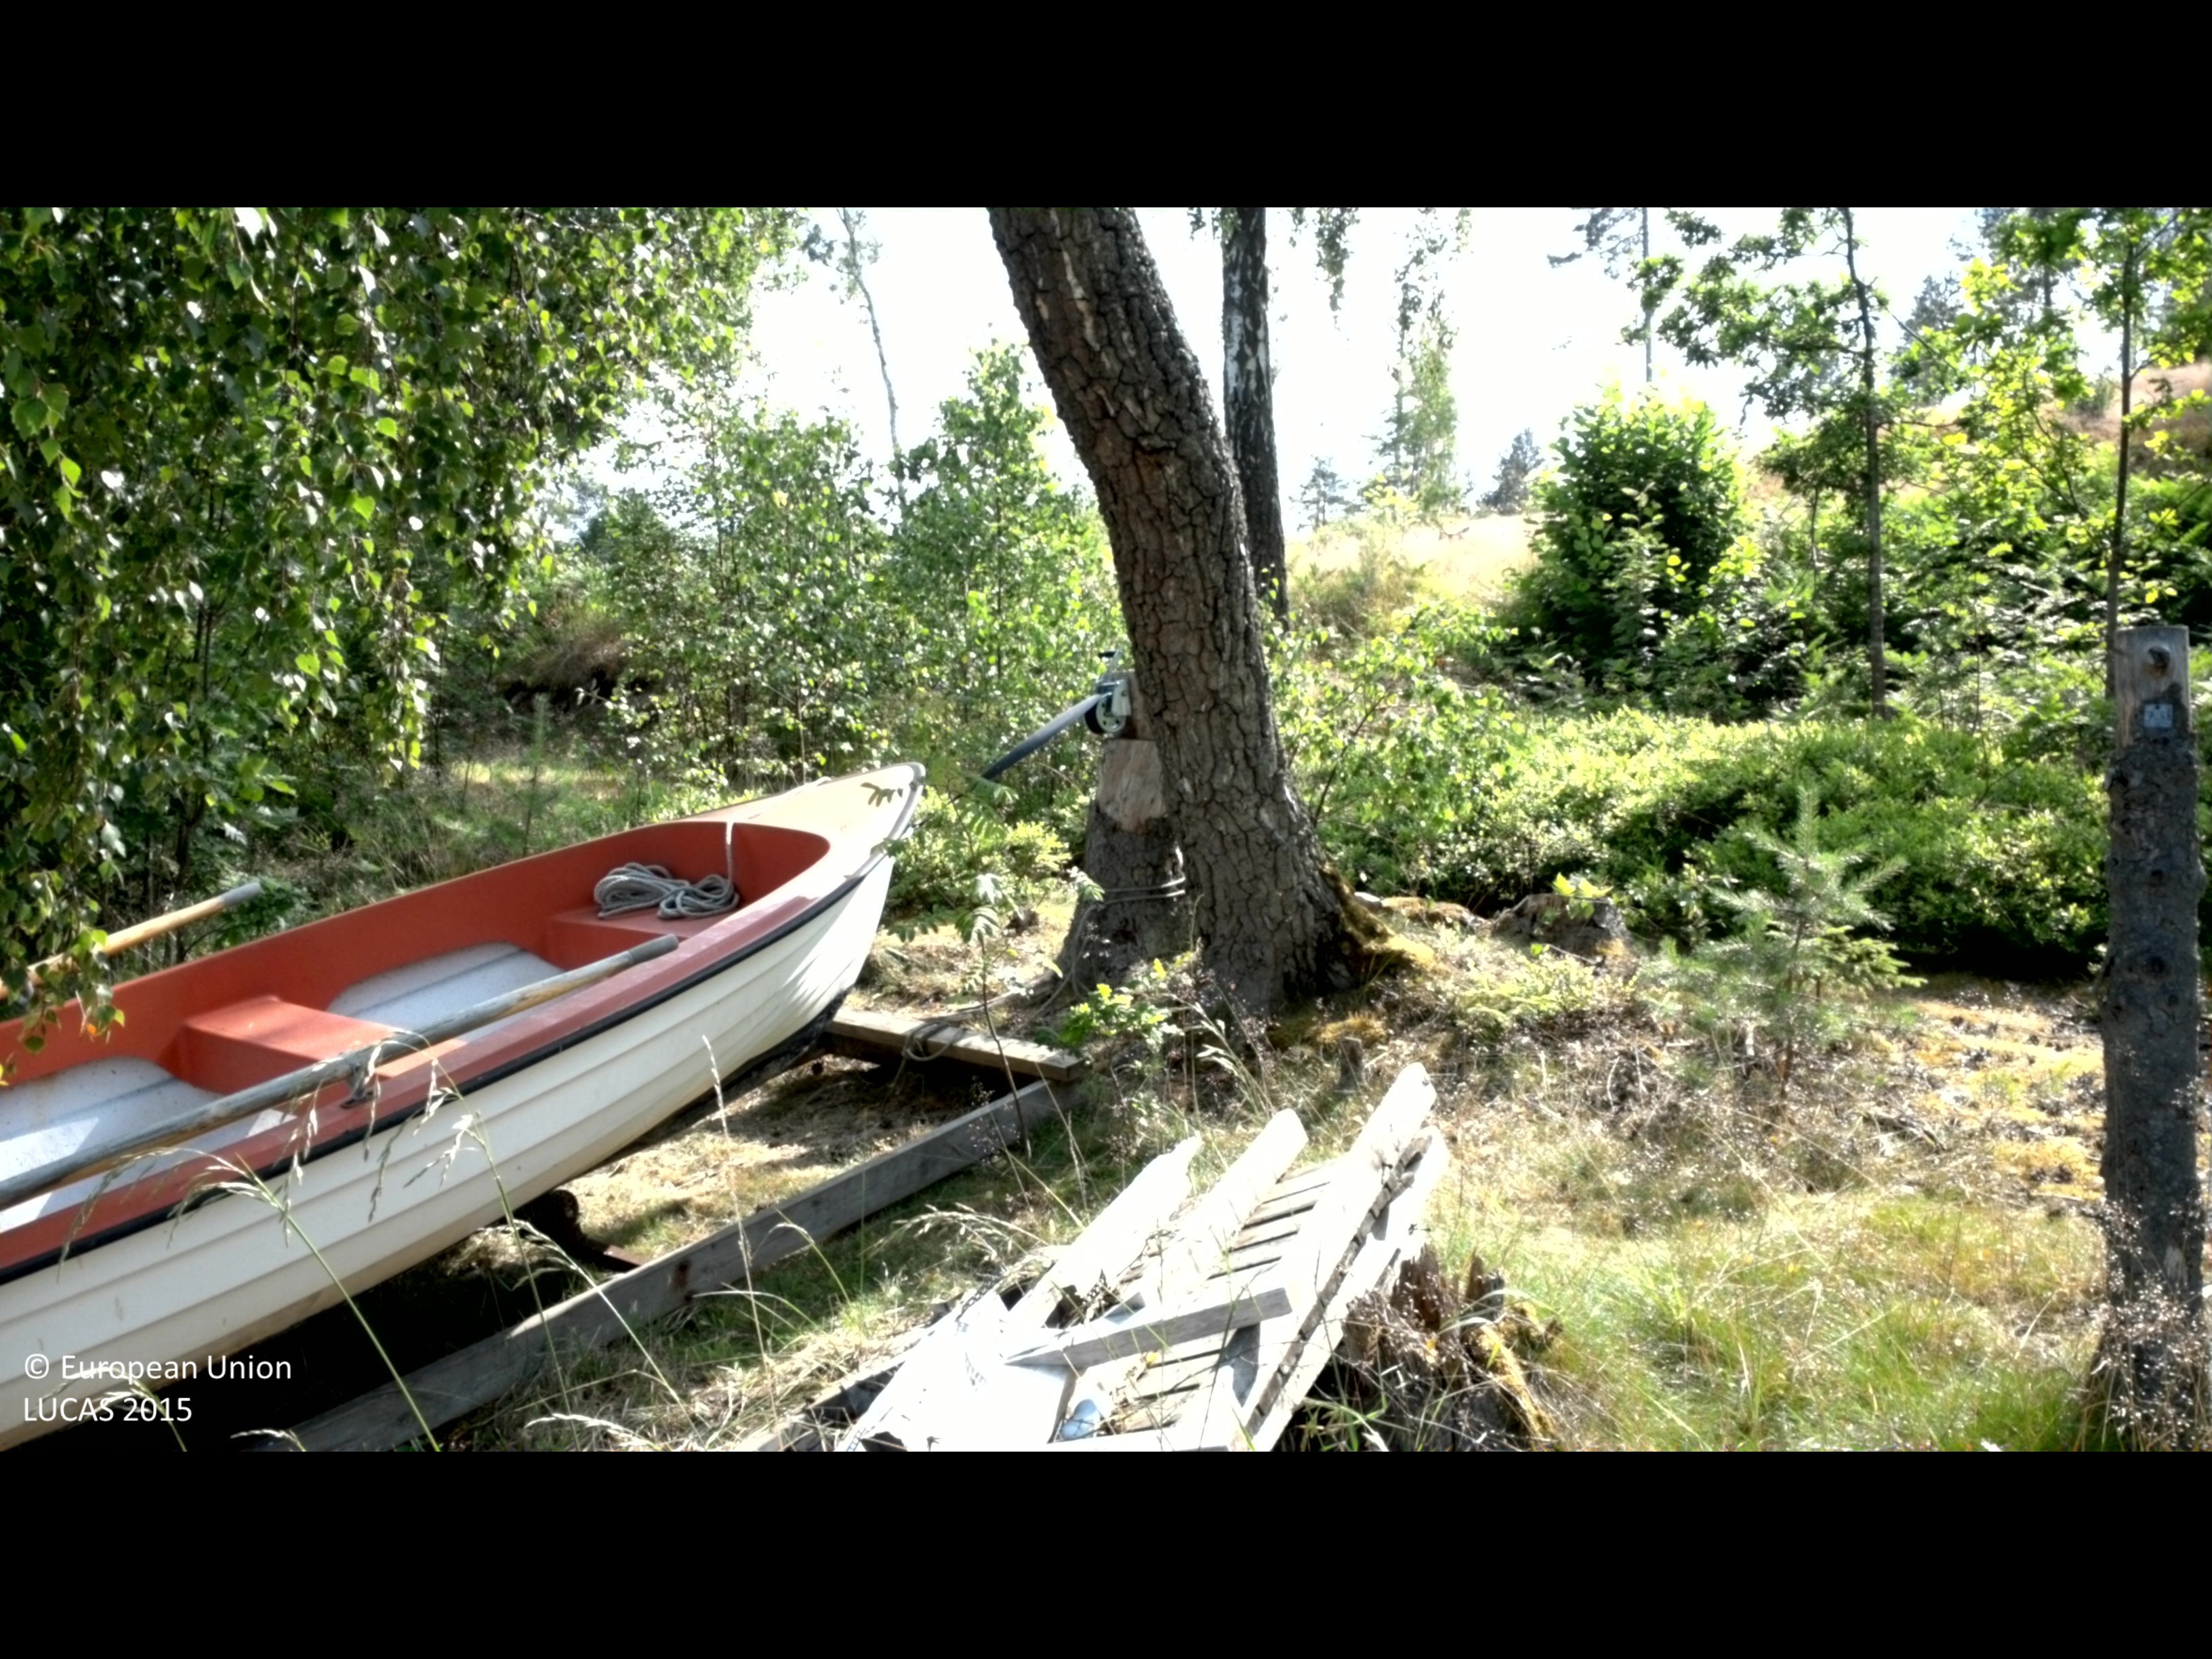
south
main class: Woodland
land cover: Broadleaved woodland
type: boreal forest
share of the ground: 50 - 75 %
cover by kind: broadleaved forest trees 65 %, shrubs 25 %, coniferous forest trees 5 %
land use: Amenities, museums, leisure
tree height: > 5 m
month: July
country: SE
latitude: 58.3229
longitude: 16.7071
